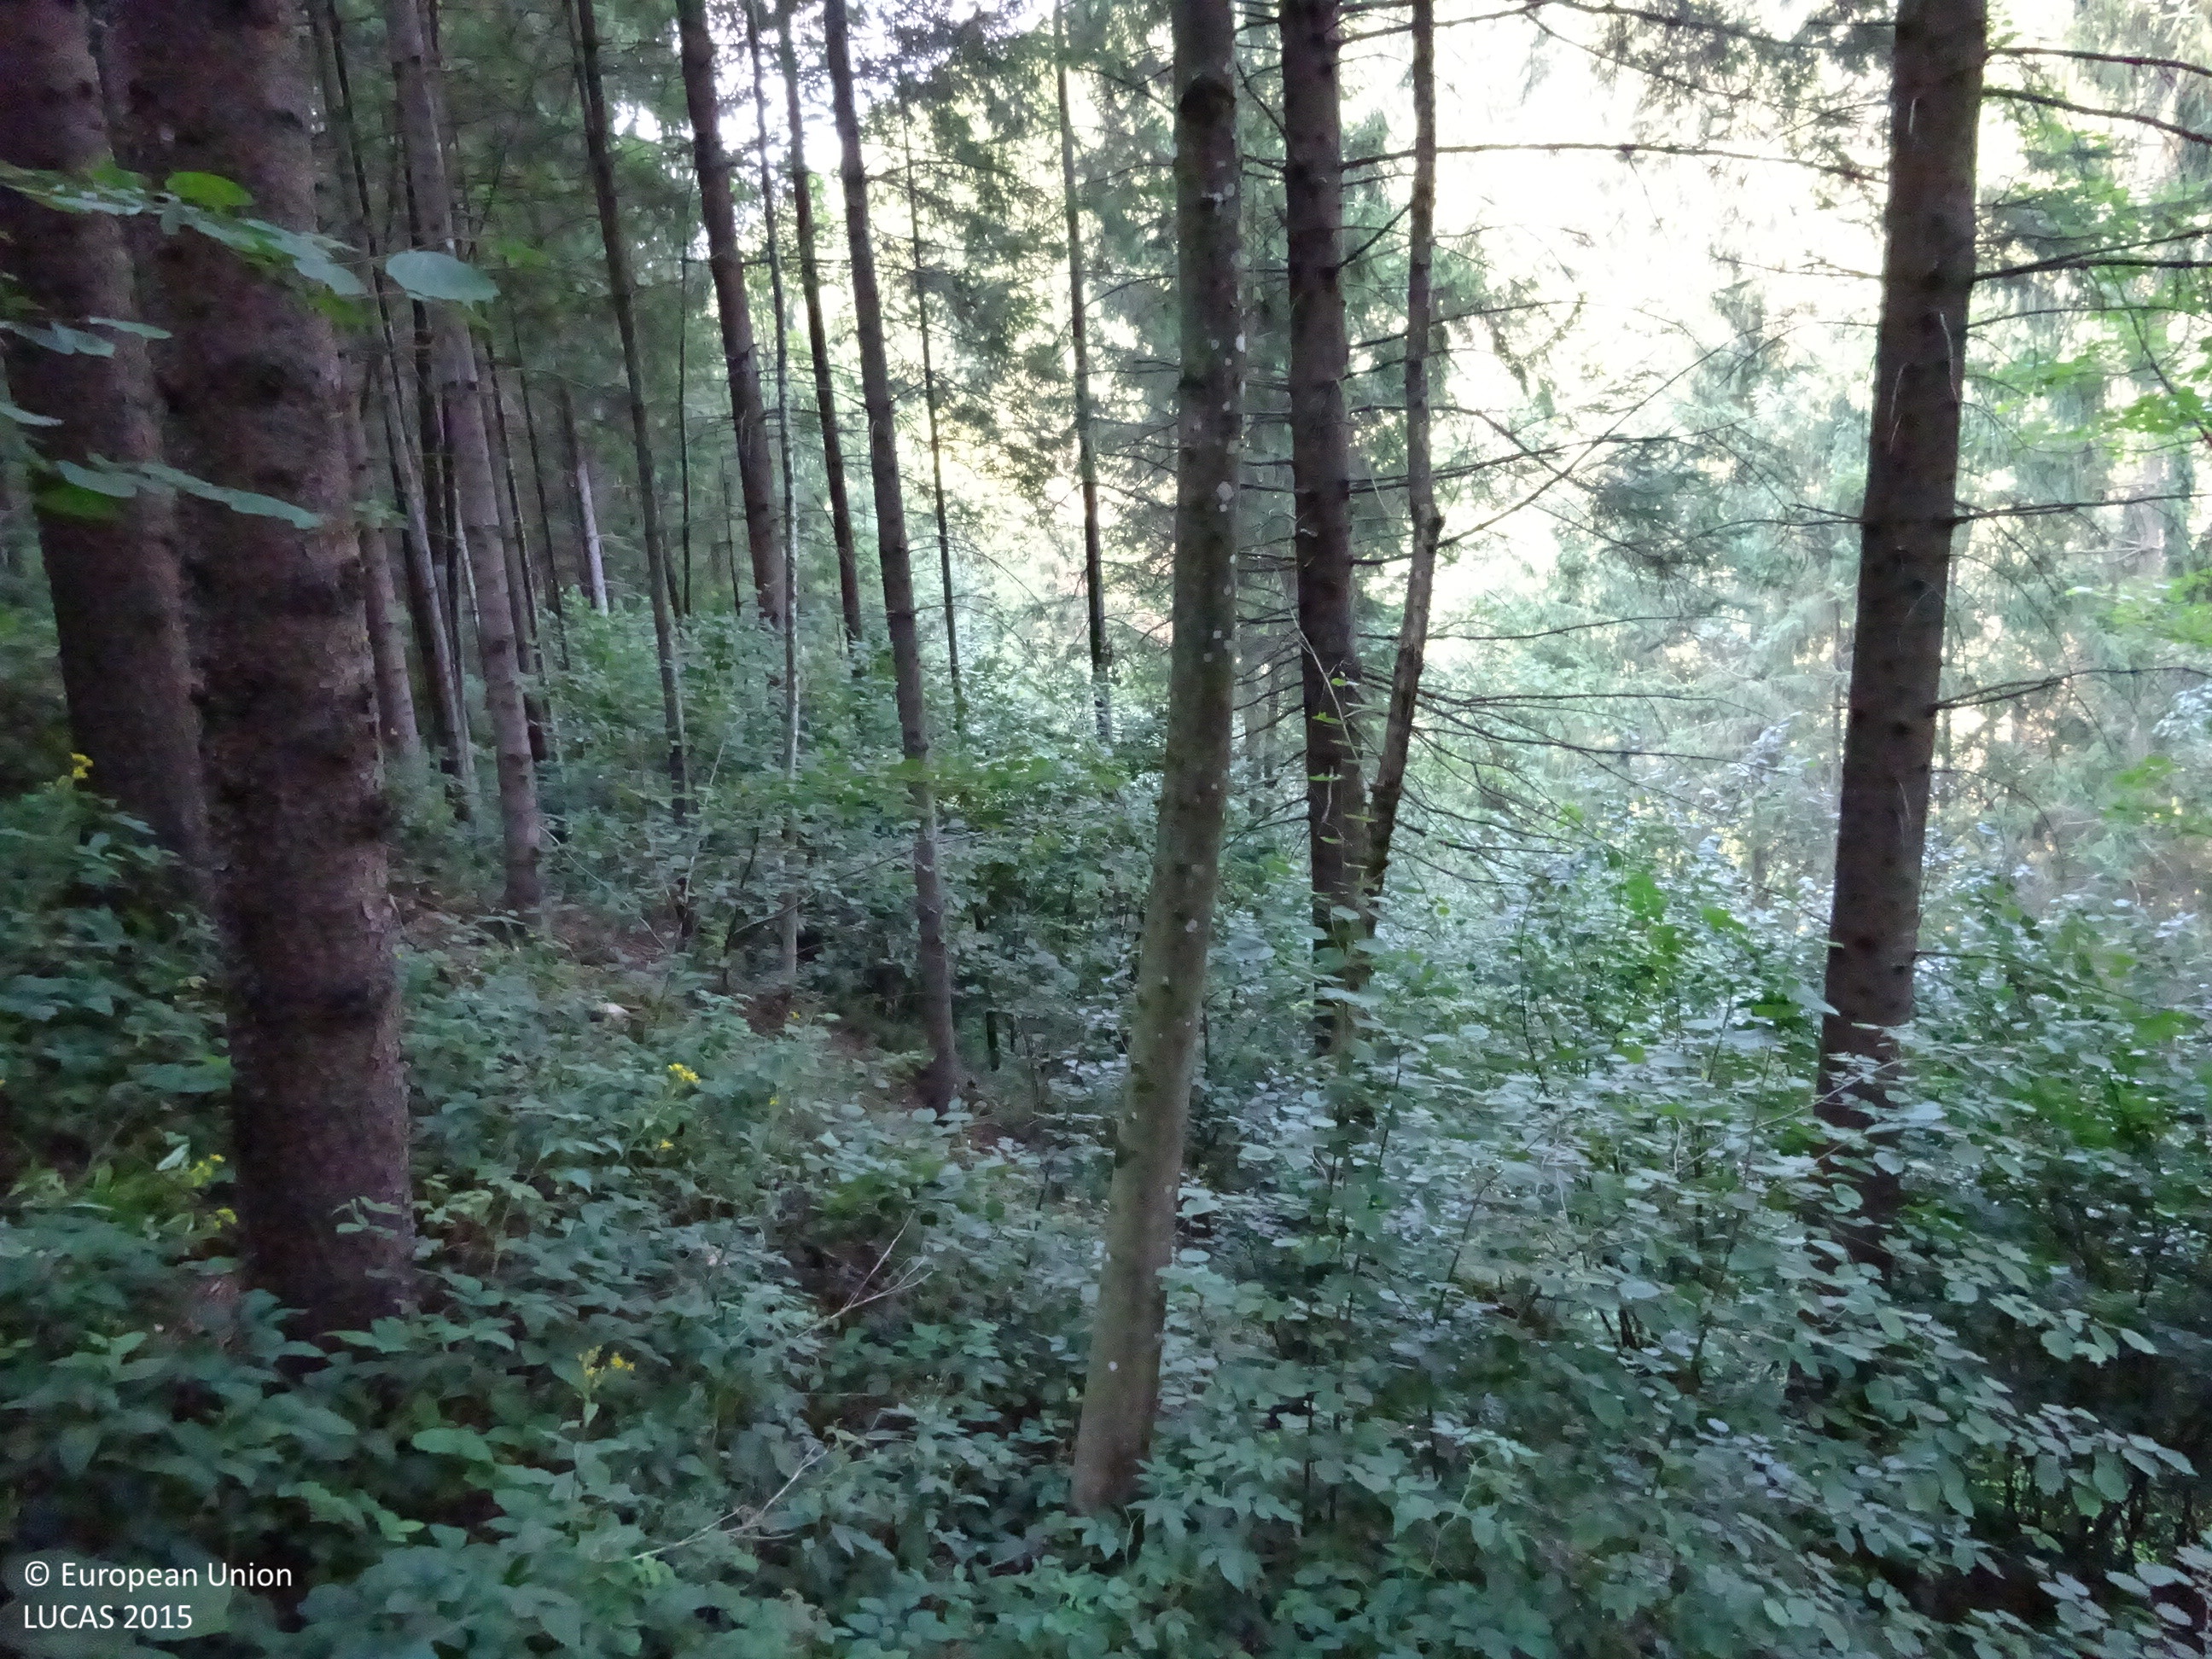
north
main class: Woodland
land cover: Spruce dominated mixed woodland
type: alpine coniferous forest
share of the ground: > 75 %
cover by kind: coniferous forest trees 50 %, broadleaved forest trees 40 %, shrubs 10 %
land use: Forestry
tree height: > 5 m
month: August
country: AT
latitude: 47.4116
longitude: 15.9791
